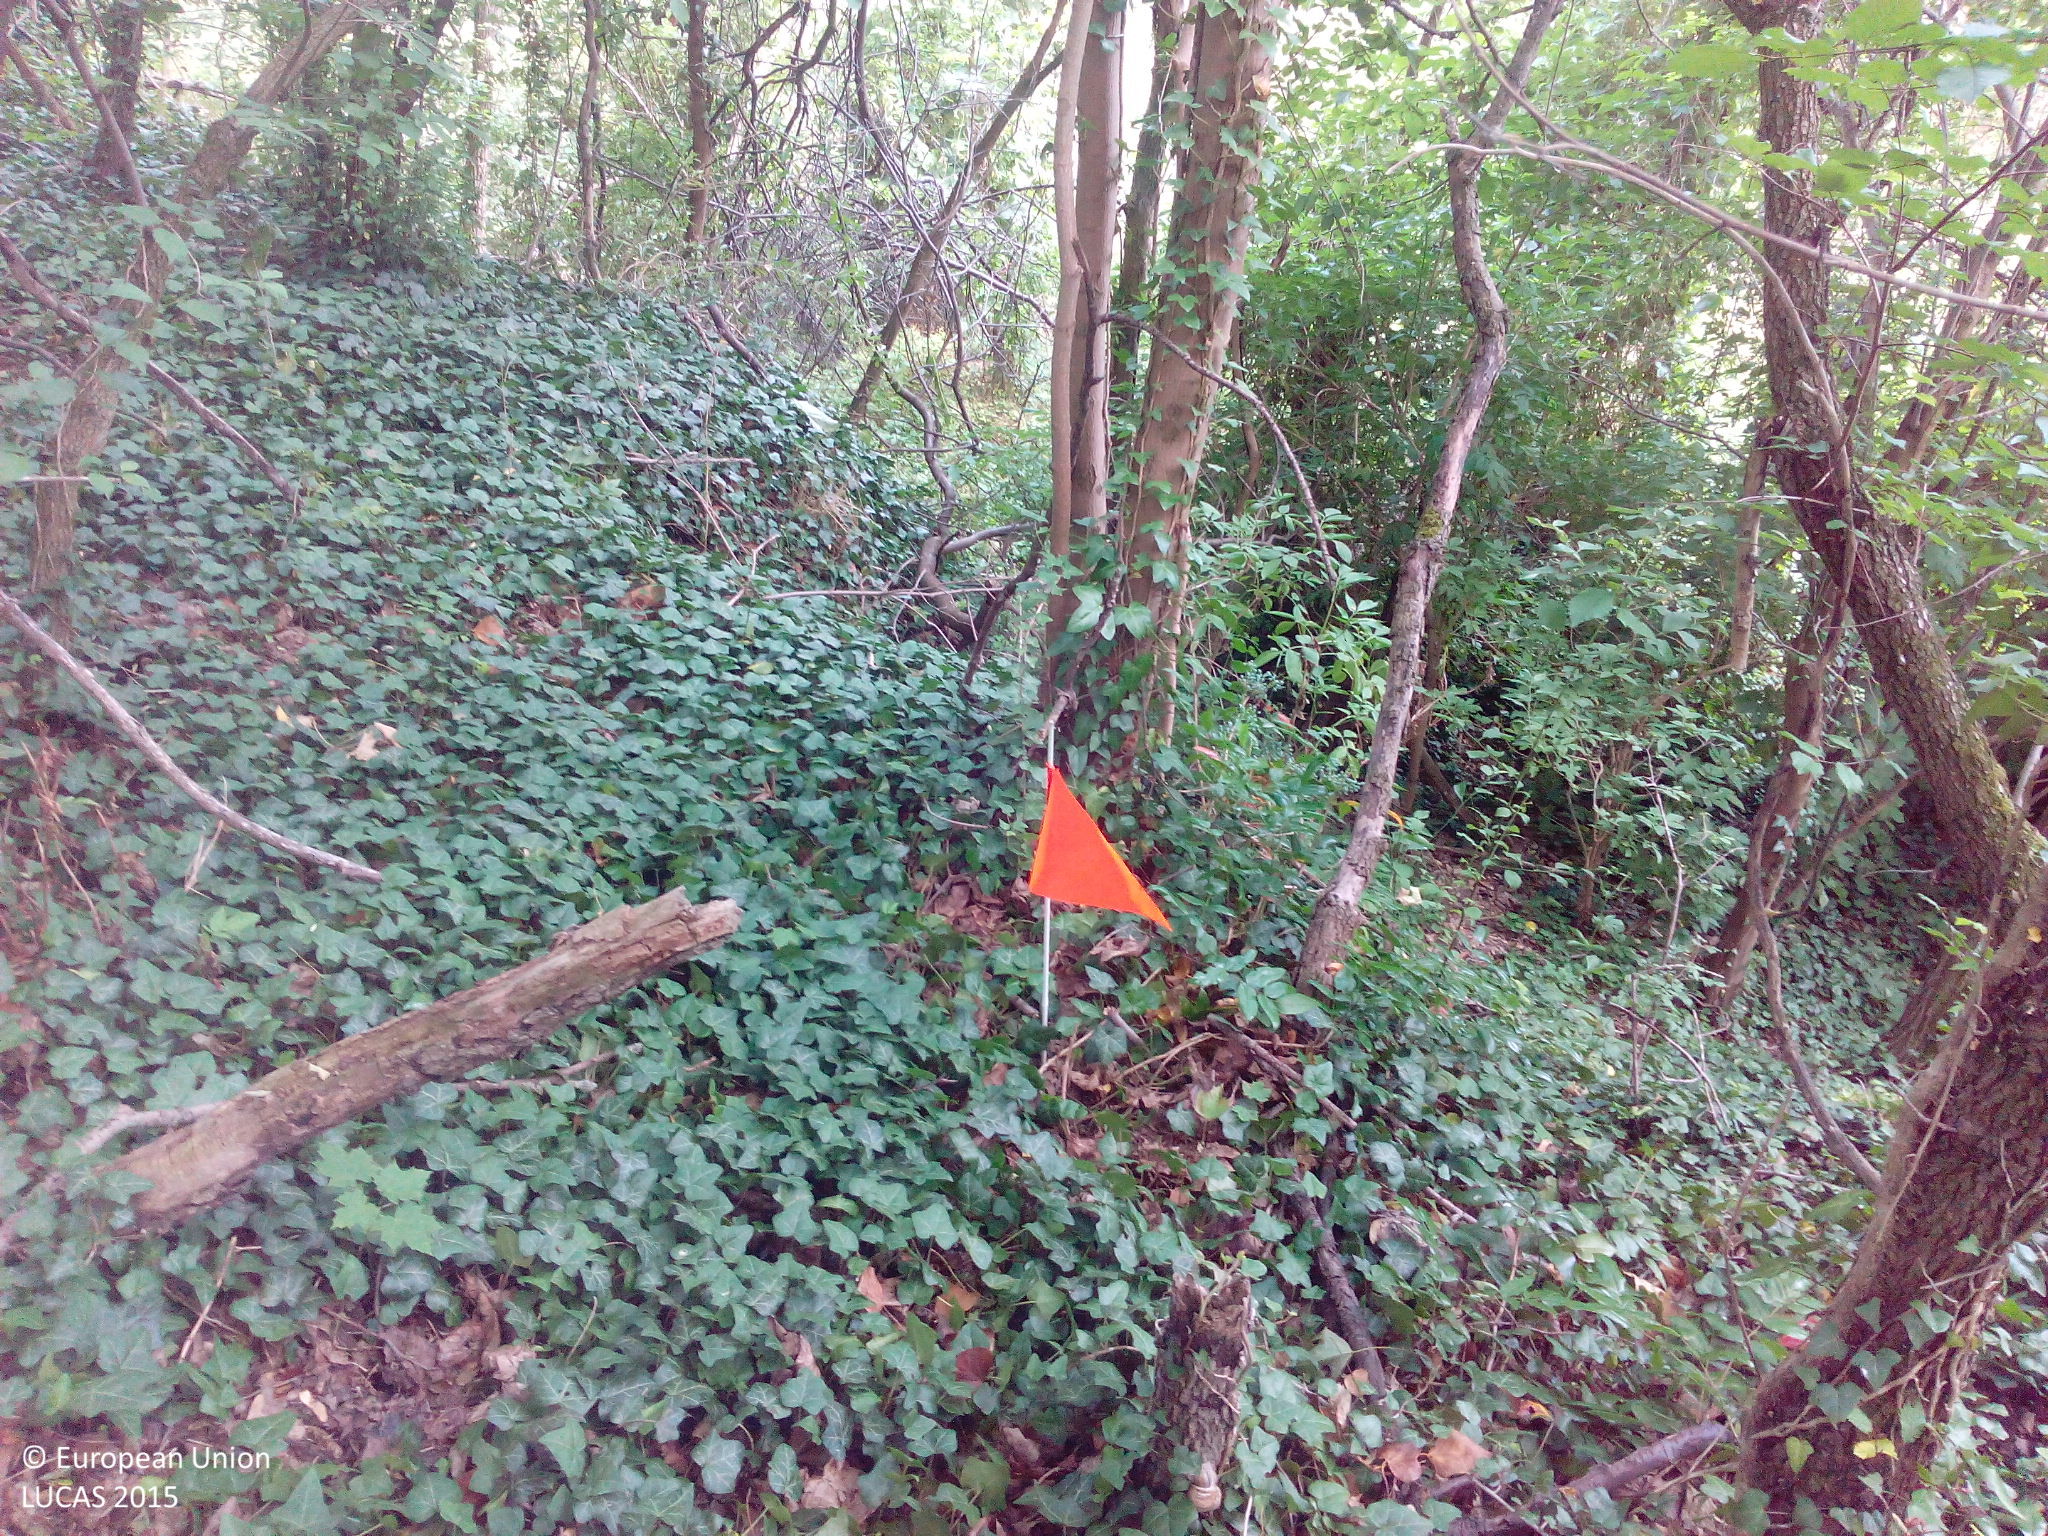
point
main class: Woodland
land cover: Broadleaved woodland
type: mesophytic deciduous forest
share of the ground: > 75 %
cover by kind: broadleaved forest trees 100 %
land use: Semi-natural and natural areas not in use
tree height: > 5 m
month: July
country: DE
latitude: 52.0257
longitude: 11.5590
